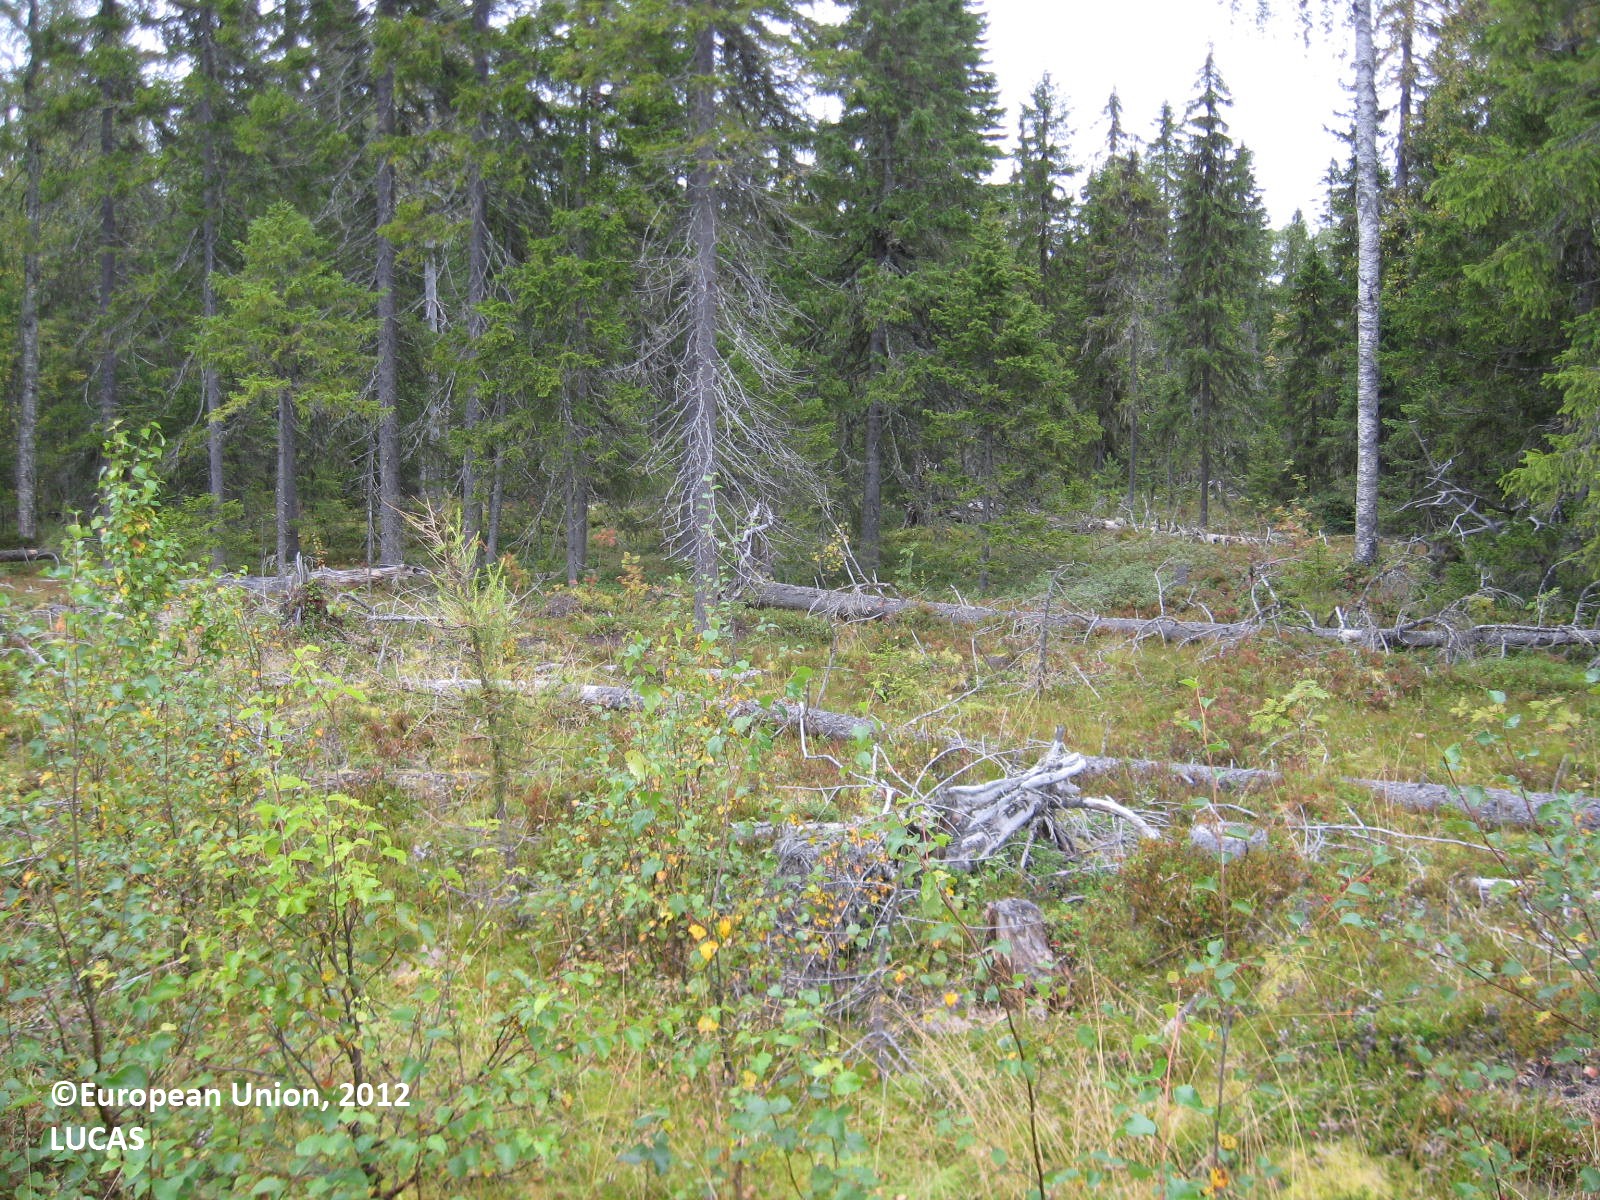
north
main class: Woodland
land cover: Other mixed woodland
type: boreal forest
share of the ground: > 75 %
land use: Forestry
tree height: < 5 m
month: August
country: FI
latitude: 63.8768
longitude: 29.6693
